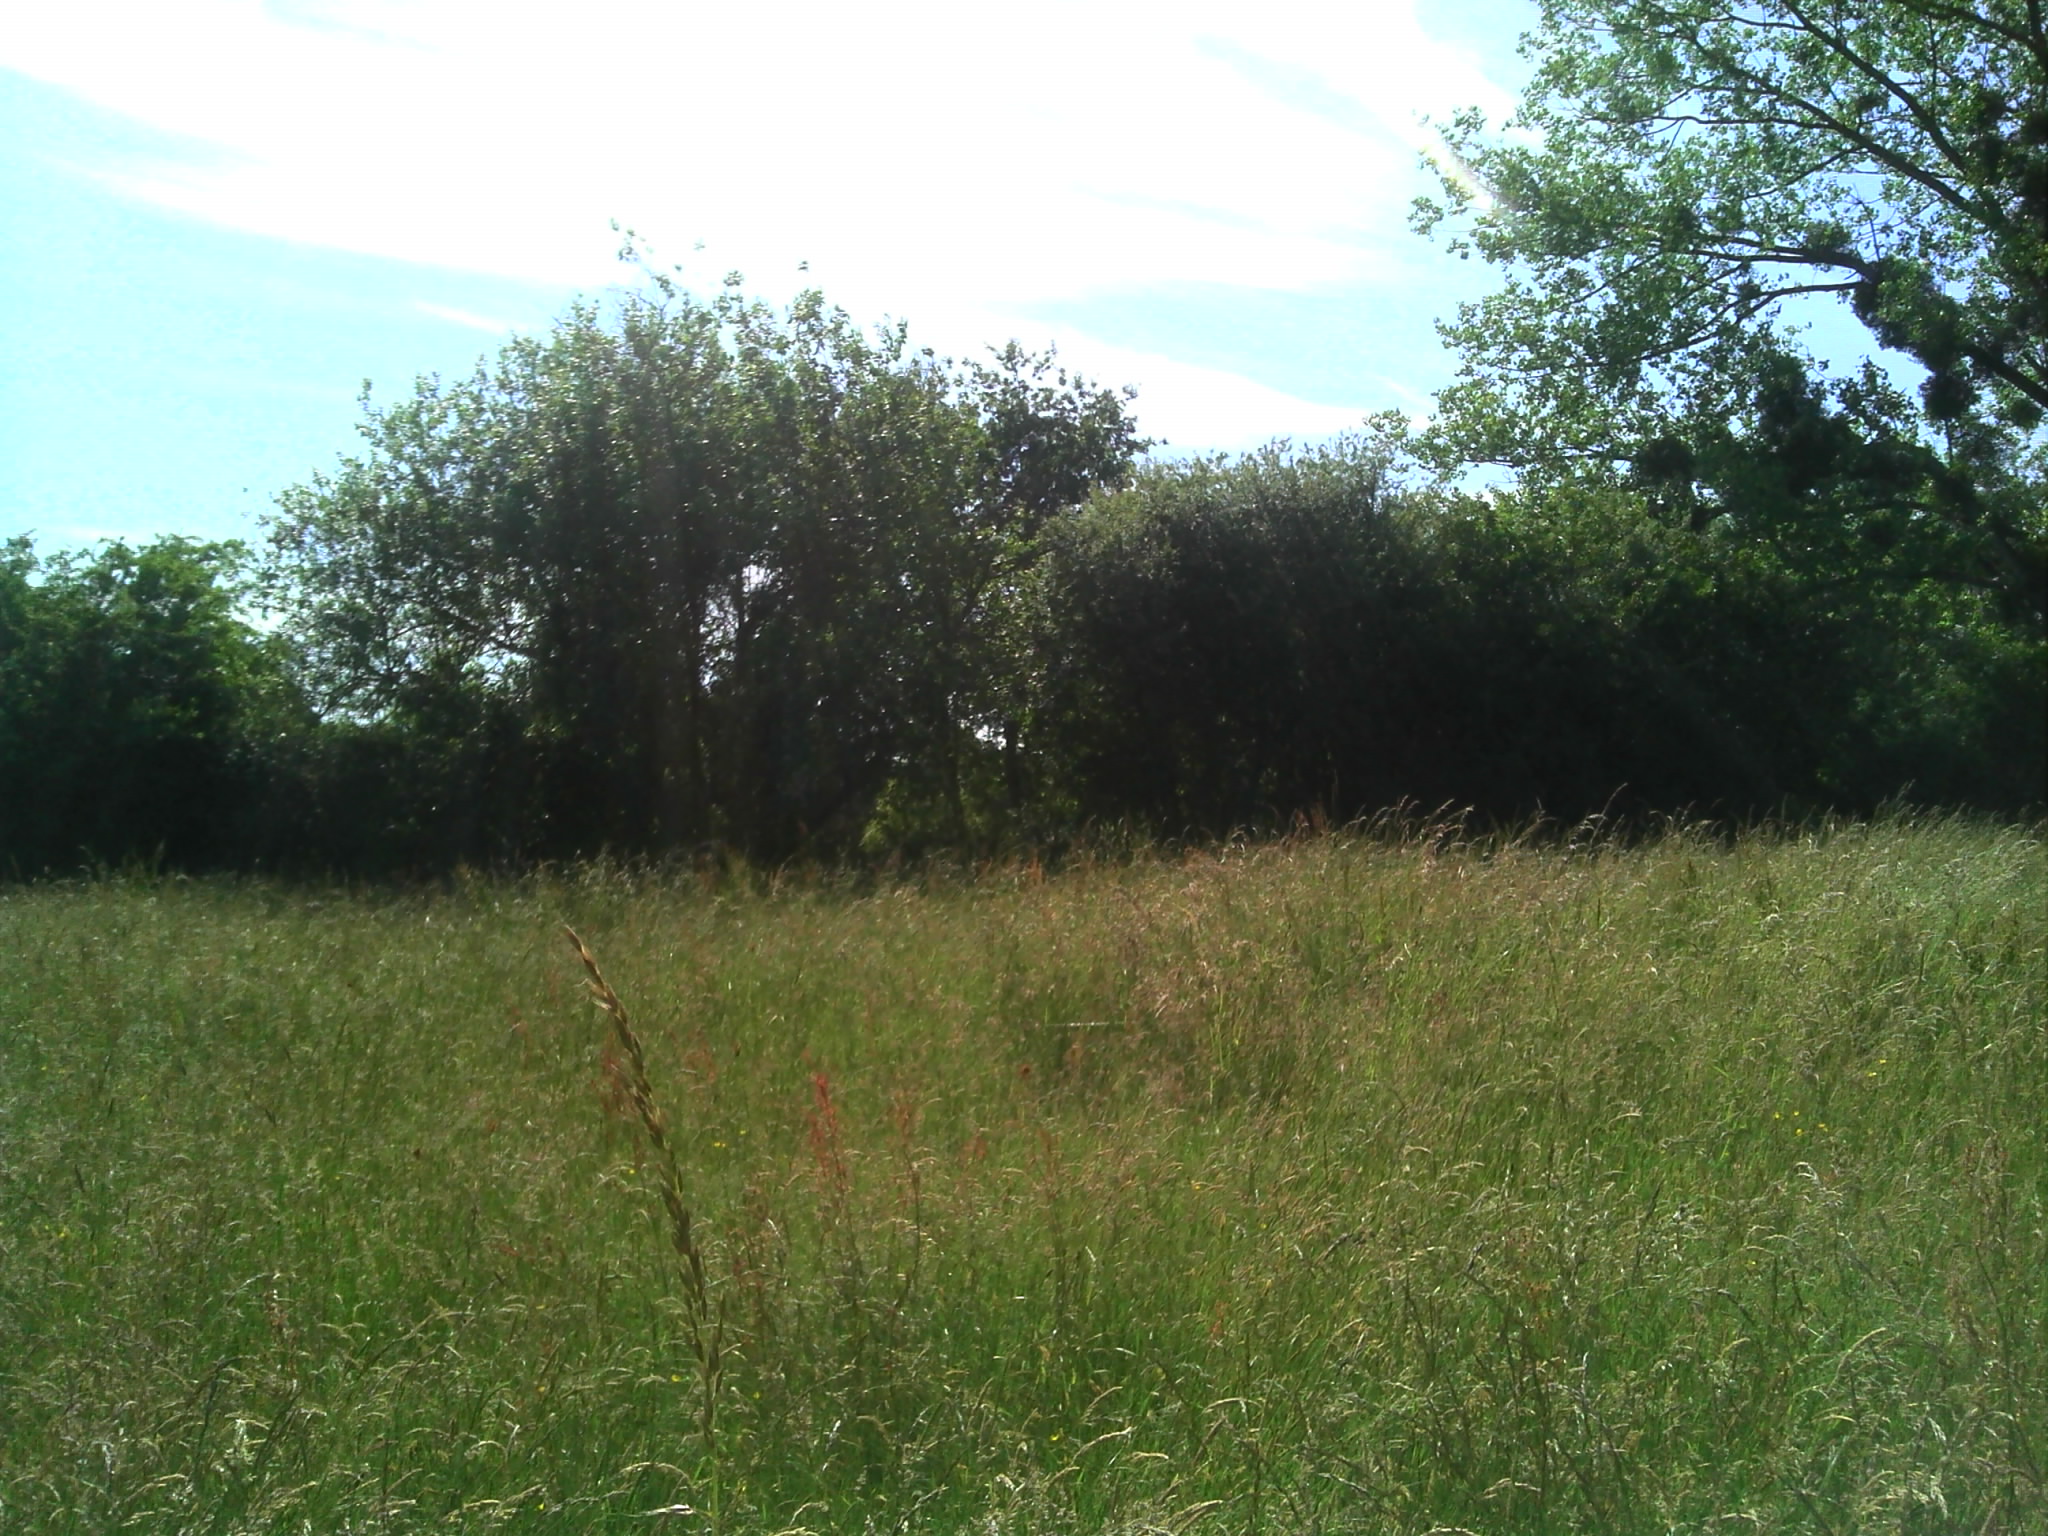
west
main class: Grassland
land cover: Grassland without tree/shrub cover
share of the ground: > 75 %
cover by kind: herbaceous plants 100 %
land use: Agriculture (excluding fallow land and kitchen gardens)
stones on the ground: < 10 %
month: May
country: FR
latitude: 46.6013
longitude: 5.1327
